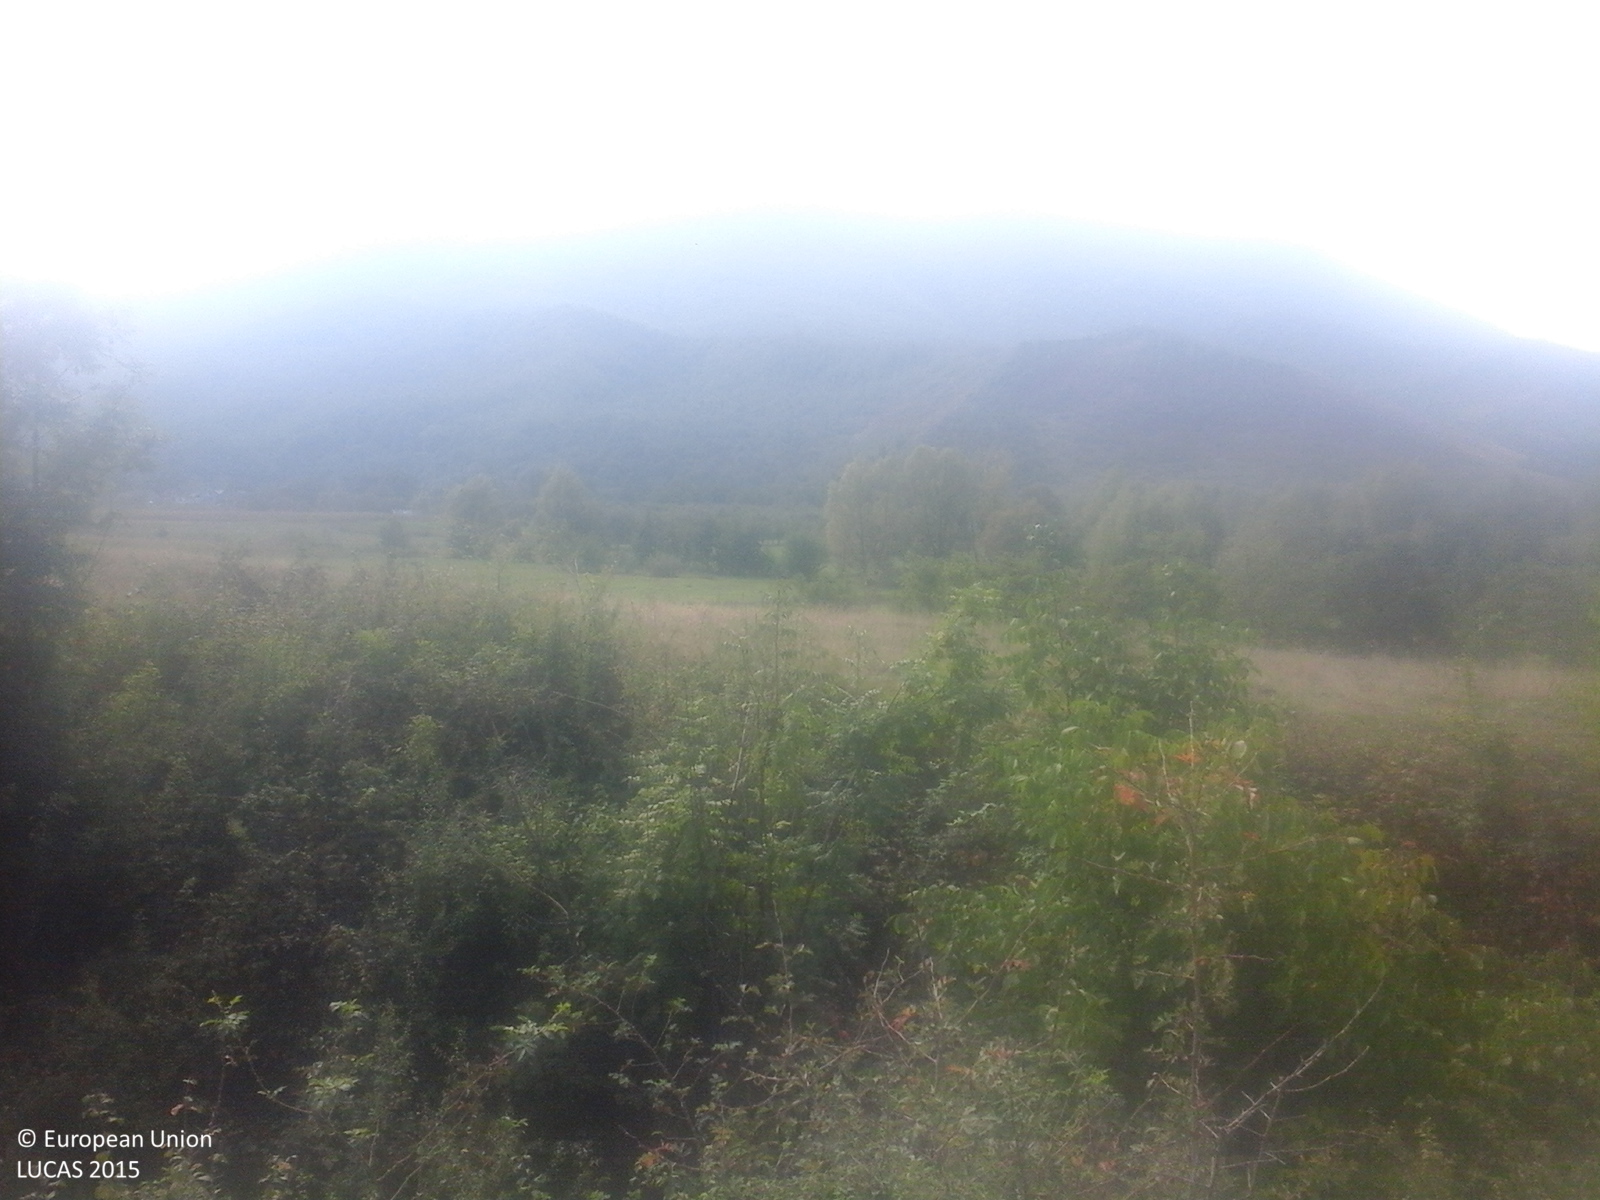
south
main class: Shrubland
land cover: Shrubland with sparse tree cover
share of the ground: > 75 %
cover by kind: herbaceous plants 65 %, shrubs 30 %, broadleaved forest trees 5 %
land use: Semi-natural and natural areas not in use
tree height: < 5 m
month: September
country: RO
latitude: 45.4981
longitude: 22.8607
